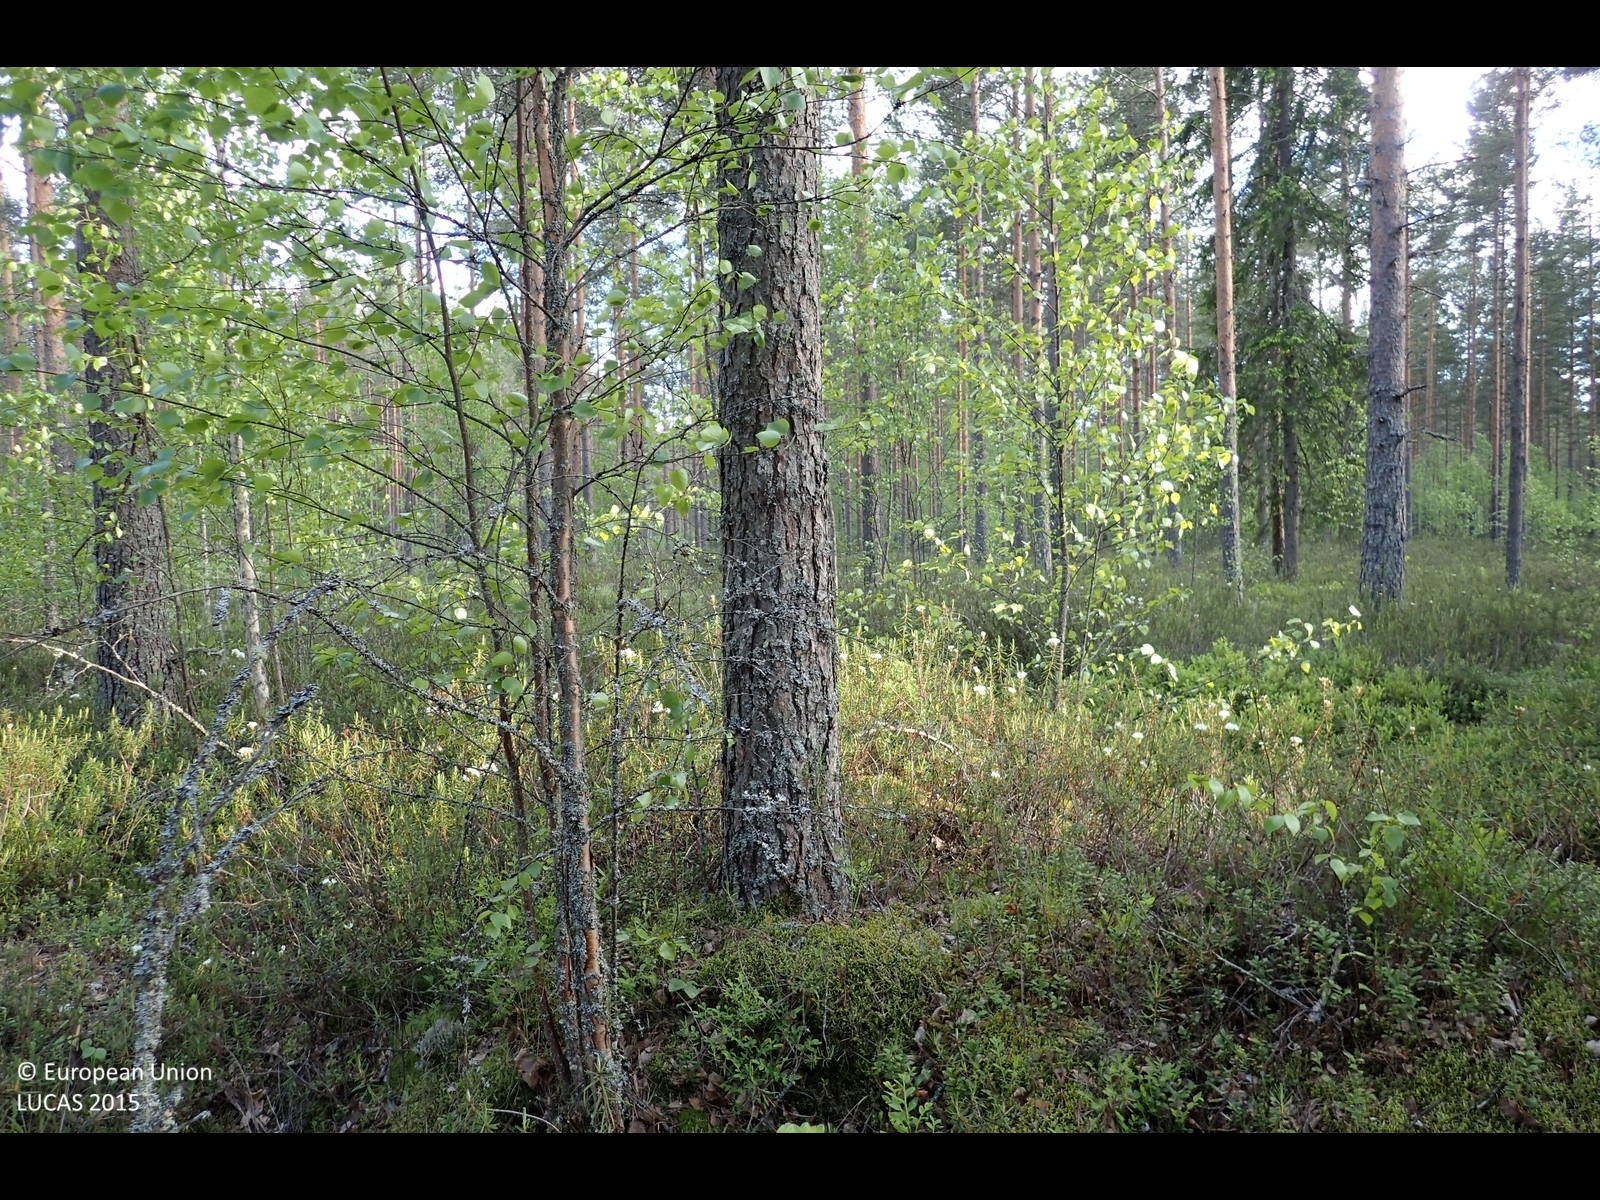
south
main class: Woodland
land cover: Pine dominated coniferous woodland
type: boreal forest
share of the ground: 25 - 50 %
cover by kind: shrubs 55 %, coniferous forest trees 40 %, broadleaved forest trees 5 %
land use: Forestry
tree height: > 5 m
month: June
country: FI
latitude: 62.4398
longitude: 23.1035
